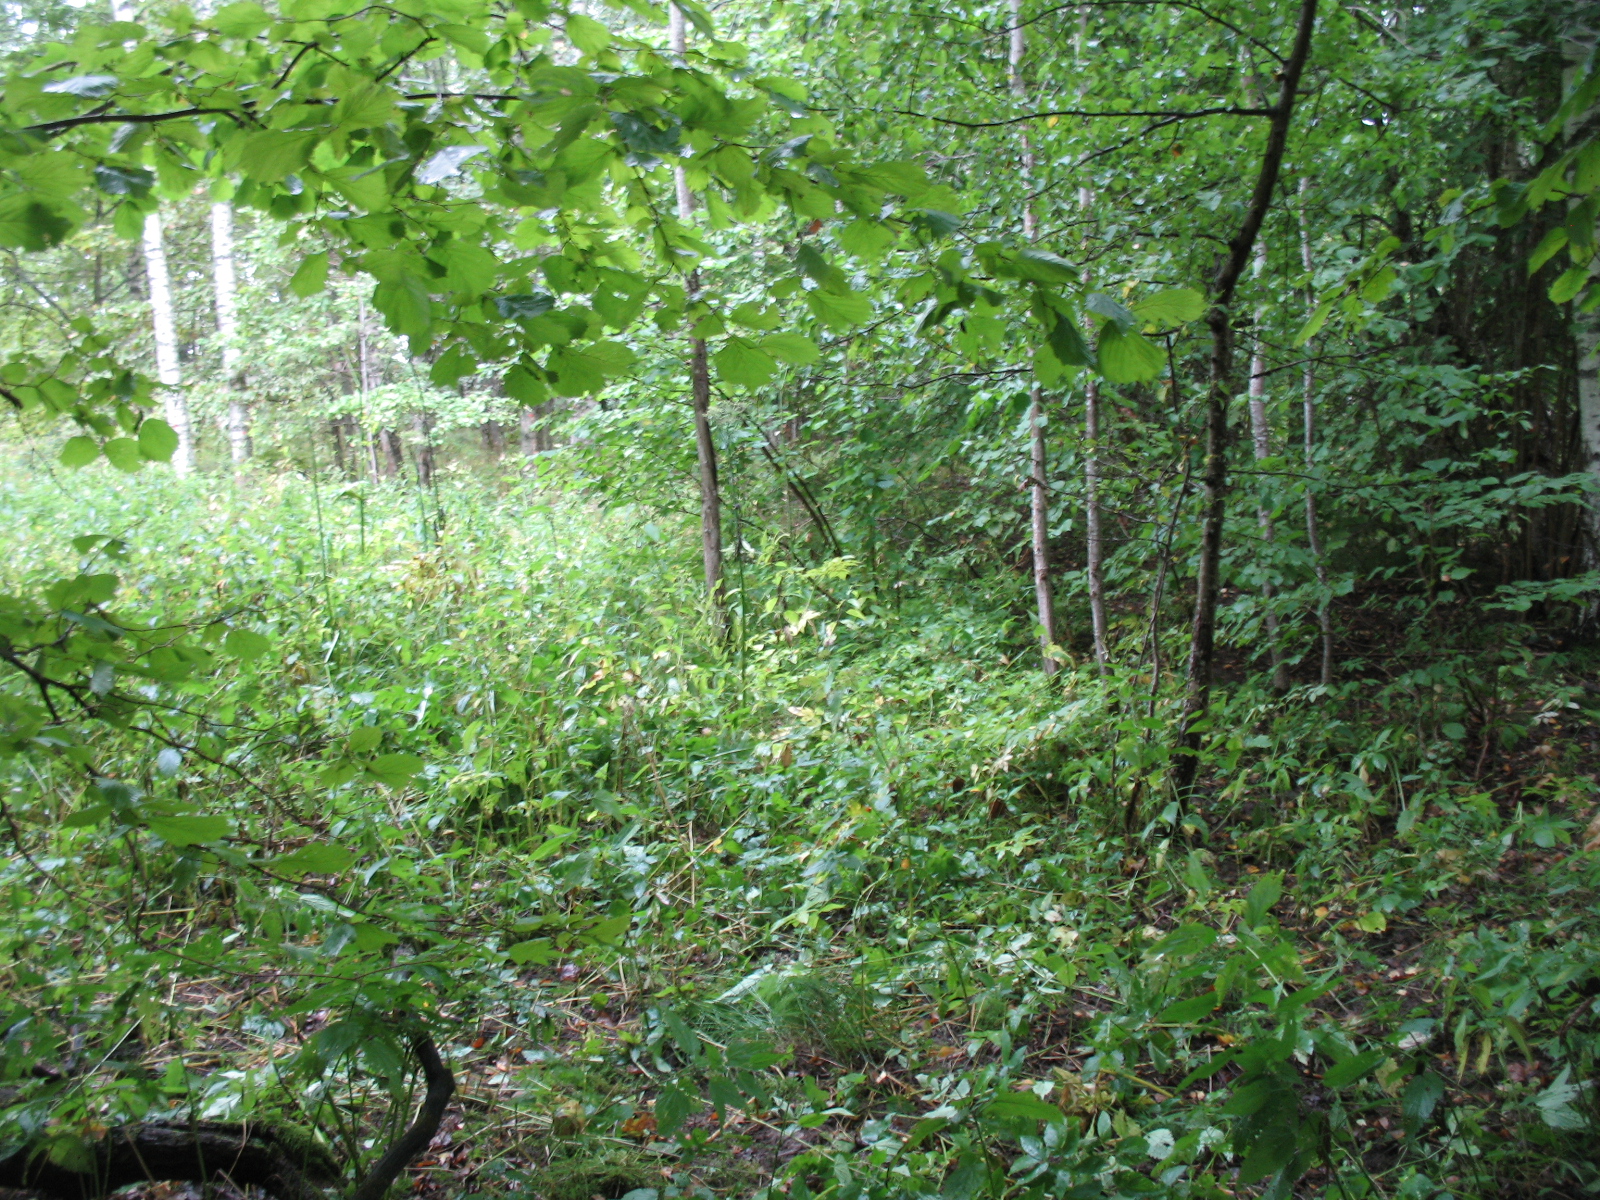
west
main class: Woodland
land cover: Broadleaved woodland
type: non-riverine alder, birch or aspen forest
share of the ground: > 75 %
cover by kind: broadleaved forest trees 80 %, herbaceous plants 15 %, coniferous forest trees 5 %
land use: Forestry
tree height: > 5 m
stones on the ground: < 10 %
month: September
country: LV
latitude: 56.1801
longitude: 26.0364
